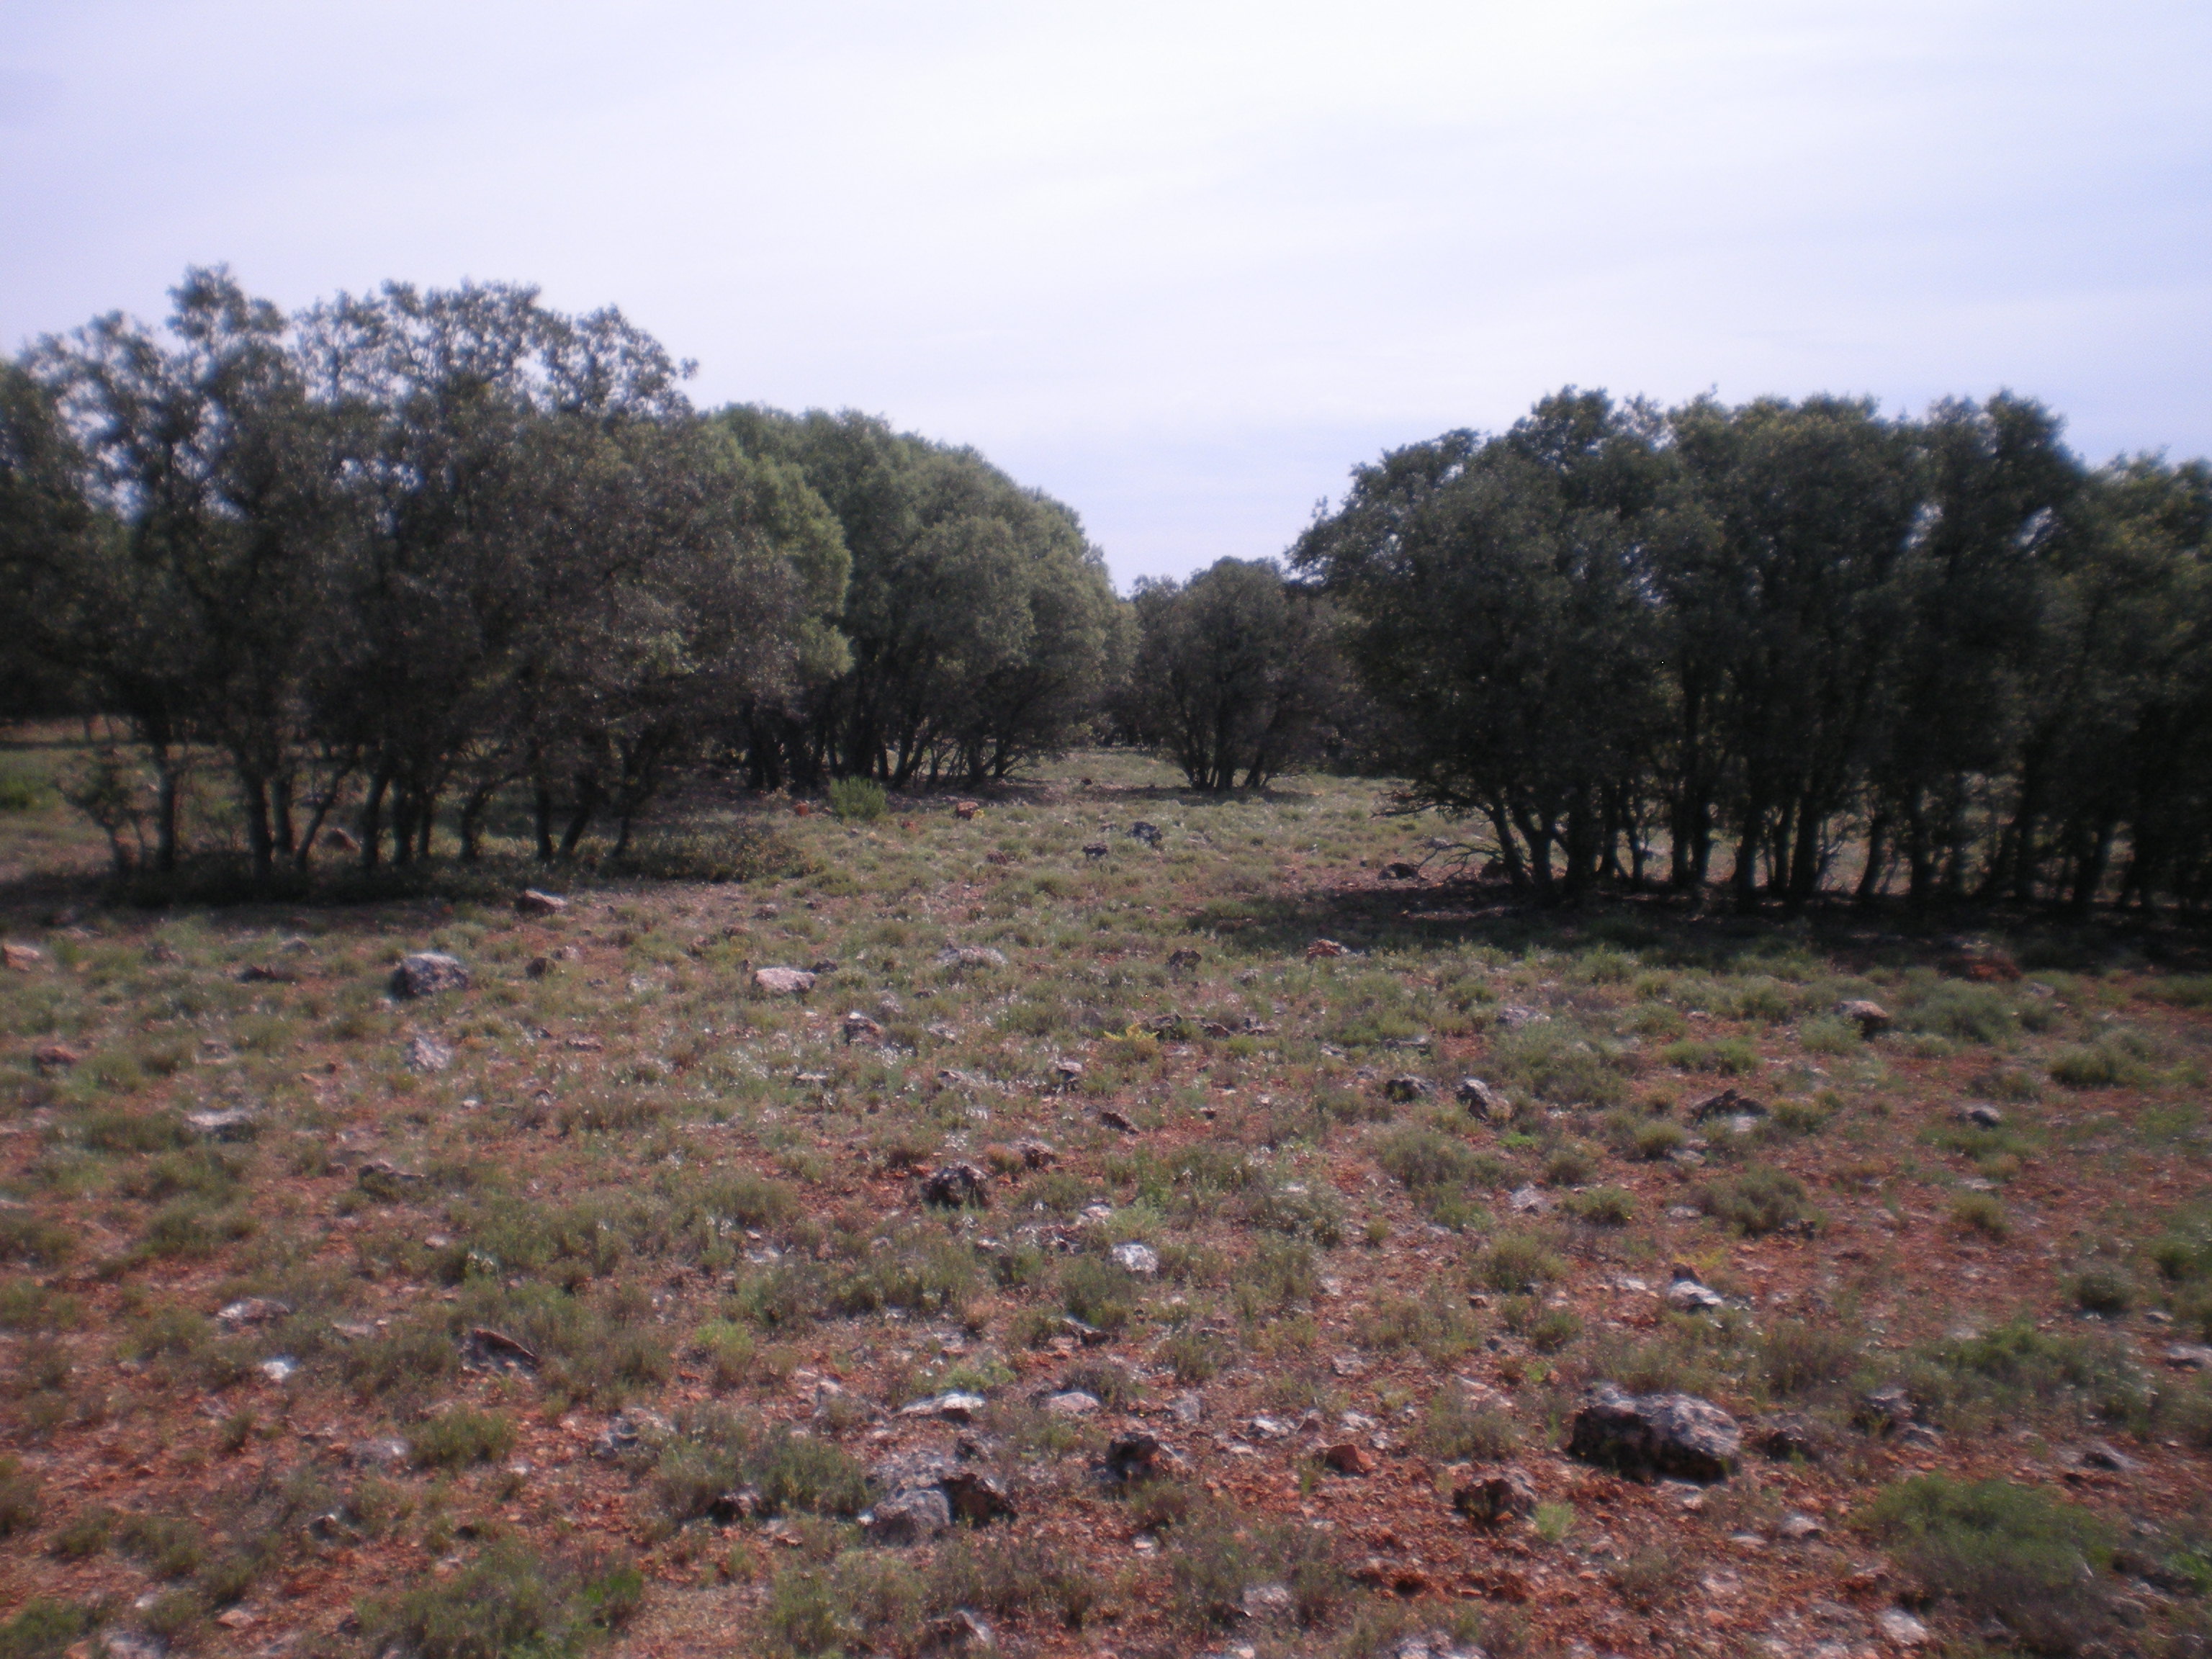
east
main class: Woodland
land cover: Broadleaved woodland
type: broadleaved evergreen forest
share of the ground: 25 - 50 %
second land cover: Shrubland without tree cover
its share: 25 - 50 %
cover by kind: unconsolidated bare surface 40 %, shrubs 35 %, broadleaved forest trees 15 %, herbaceous plants 10 %
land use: Forestry
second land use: Agriculture (excluding fallow land and kitchen gardens)
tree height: < 5 m
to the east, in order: Broadleaved woodland; Shrubland without tree cover
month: May
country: ES
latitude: 38.9126
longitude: -2.9365
